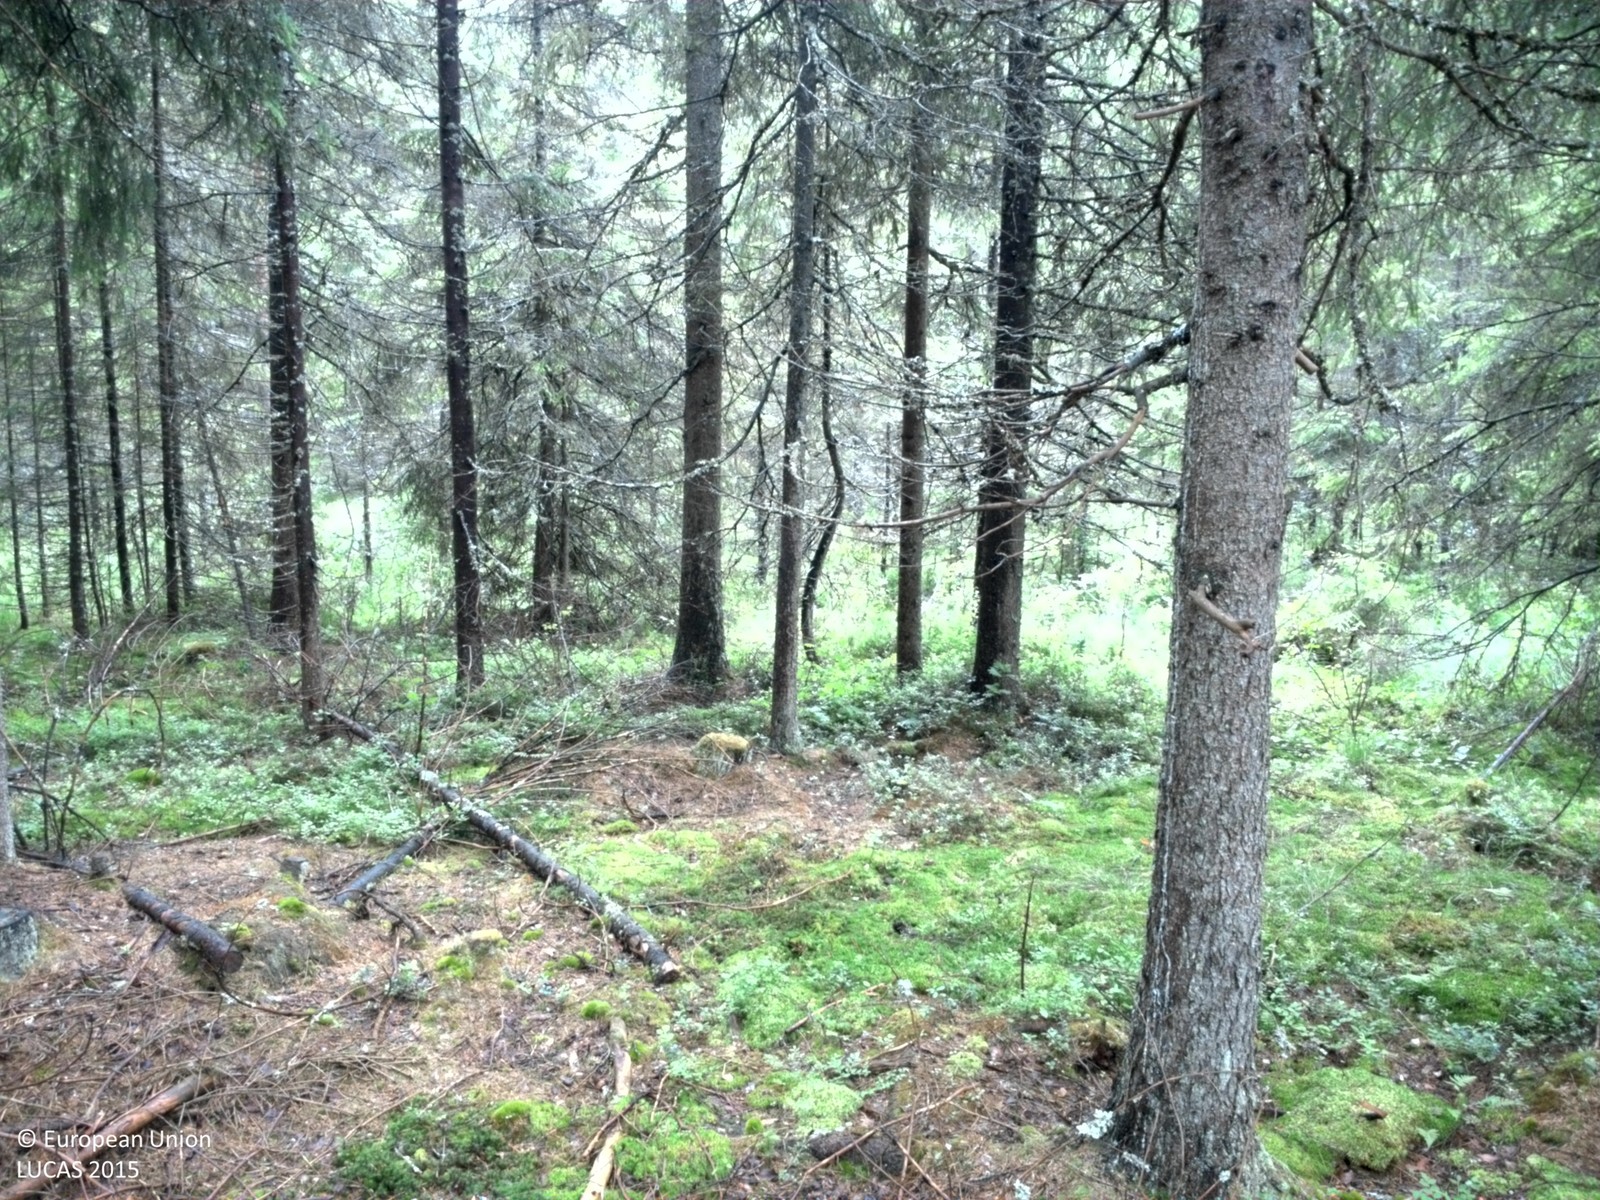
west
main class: Woodland
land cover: Spruce dominated coniferous woodland
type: boreal forest
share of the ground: 50 - 75 %
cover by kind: coniferous forest trees 55 %, shrubs 15 %, lichens and mosses 15 %, broadleaved forest trees 5 %, herbaceous plants 5 %
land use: Forestry
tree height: > 5 m
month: July
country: SE
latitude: 59.4903
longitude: 14.6706
